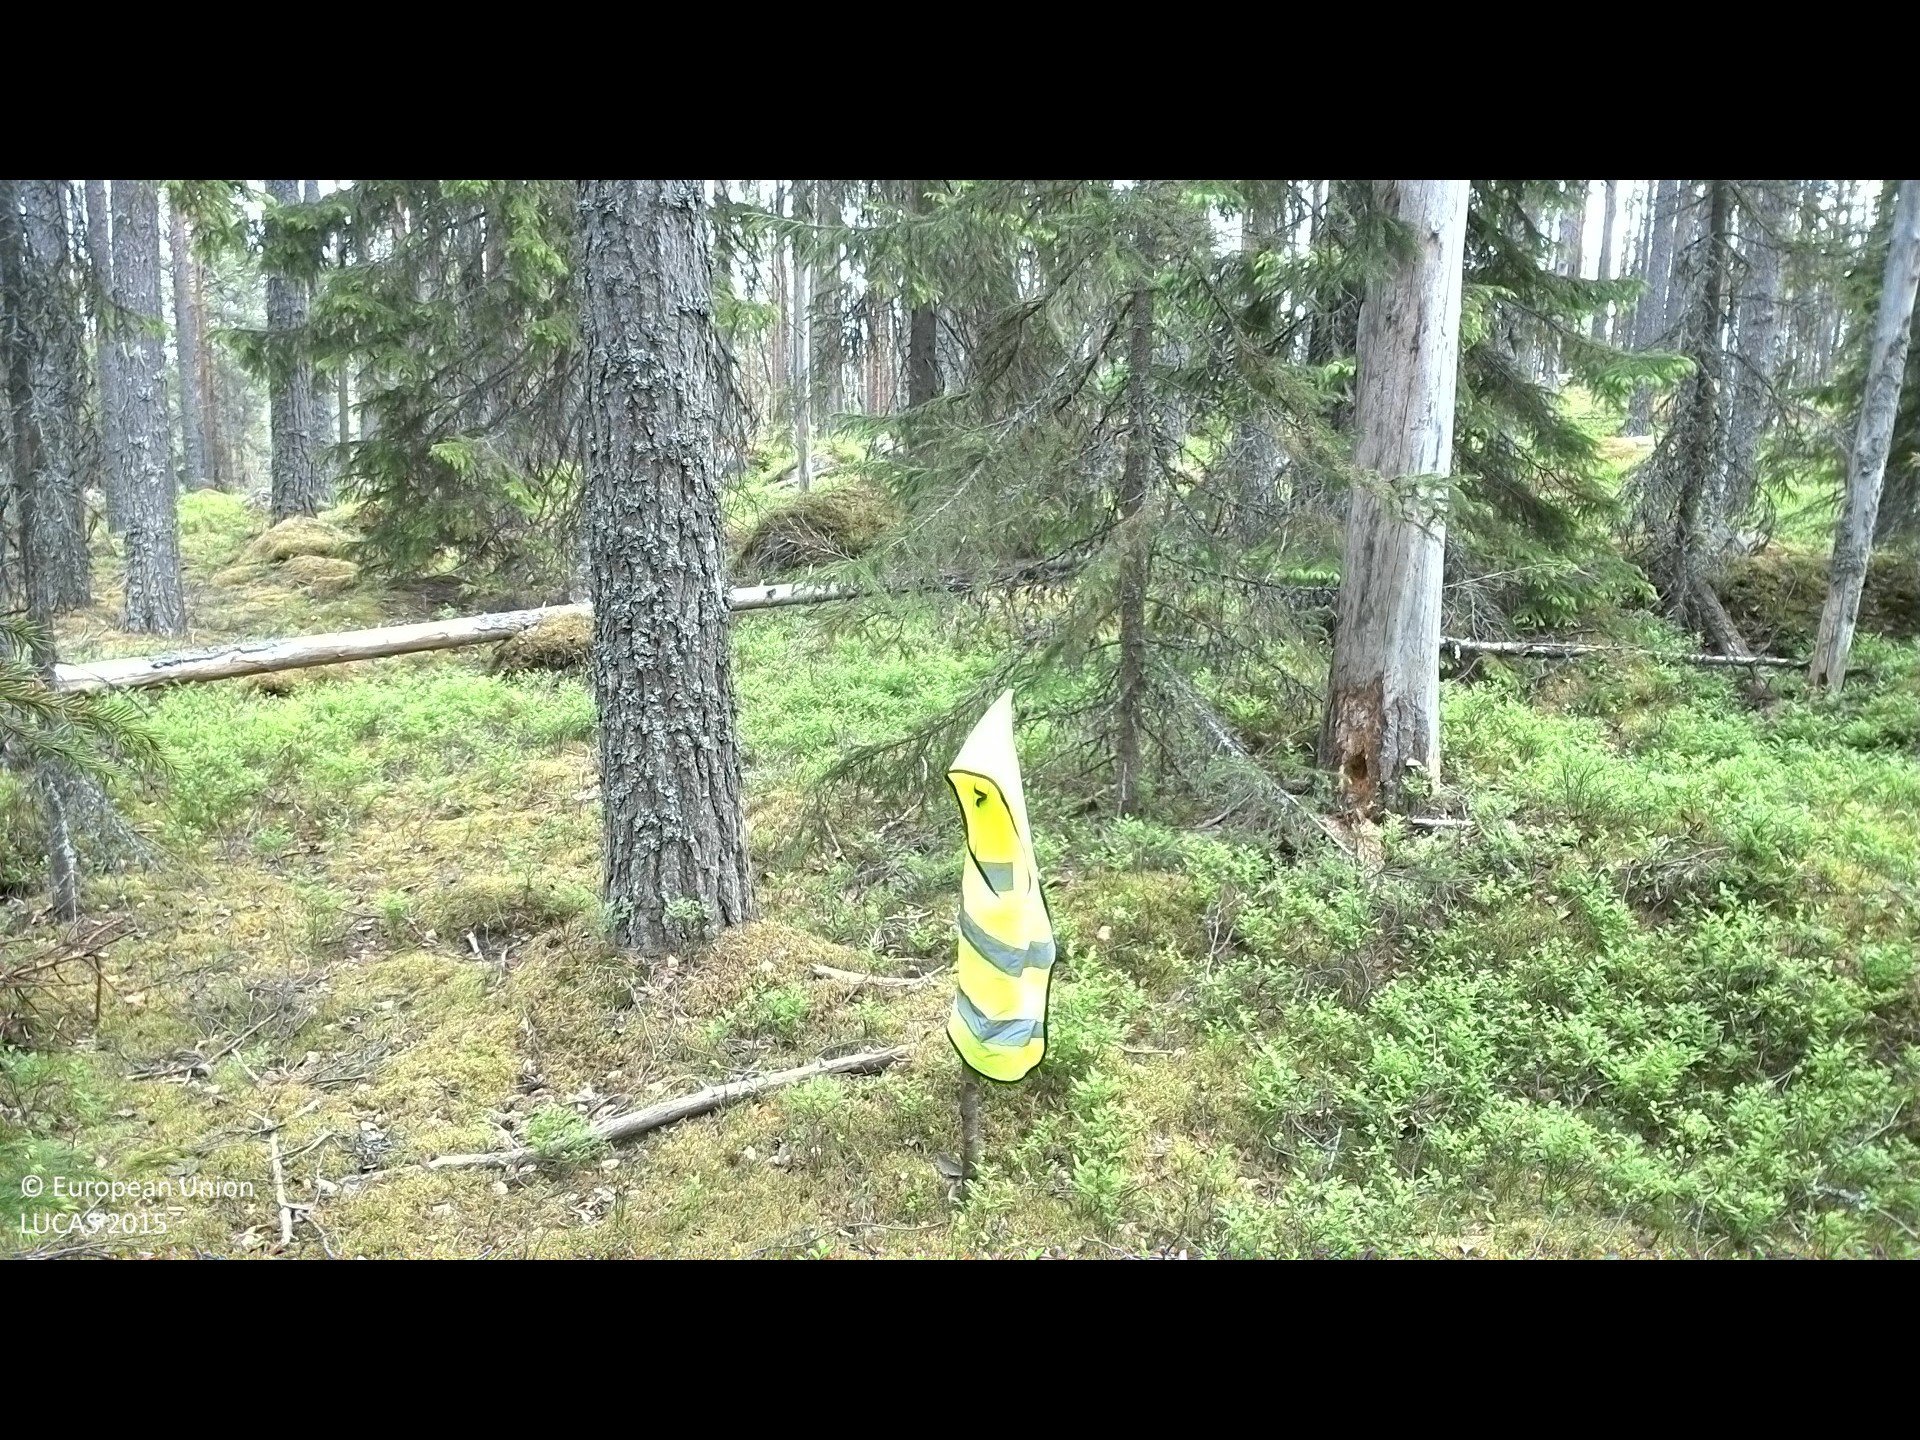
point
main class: Woodland
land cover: Pine dominated coniferous woodland
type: boreal forest
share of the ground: 25 - 50 %
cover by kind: coniferous forest trees 45 %, lichens and mosses 25 %, shrubs 20 %, broadleaved forest trees 10 %
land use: Forestry
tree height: > 5 m
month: June
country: SE
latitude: 61.9610
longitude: 16.1794
